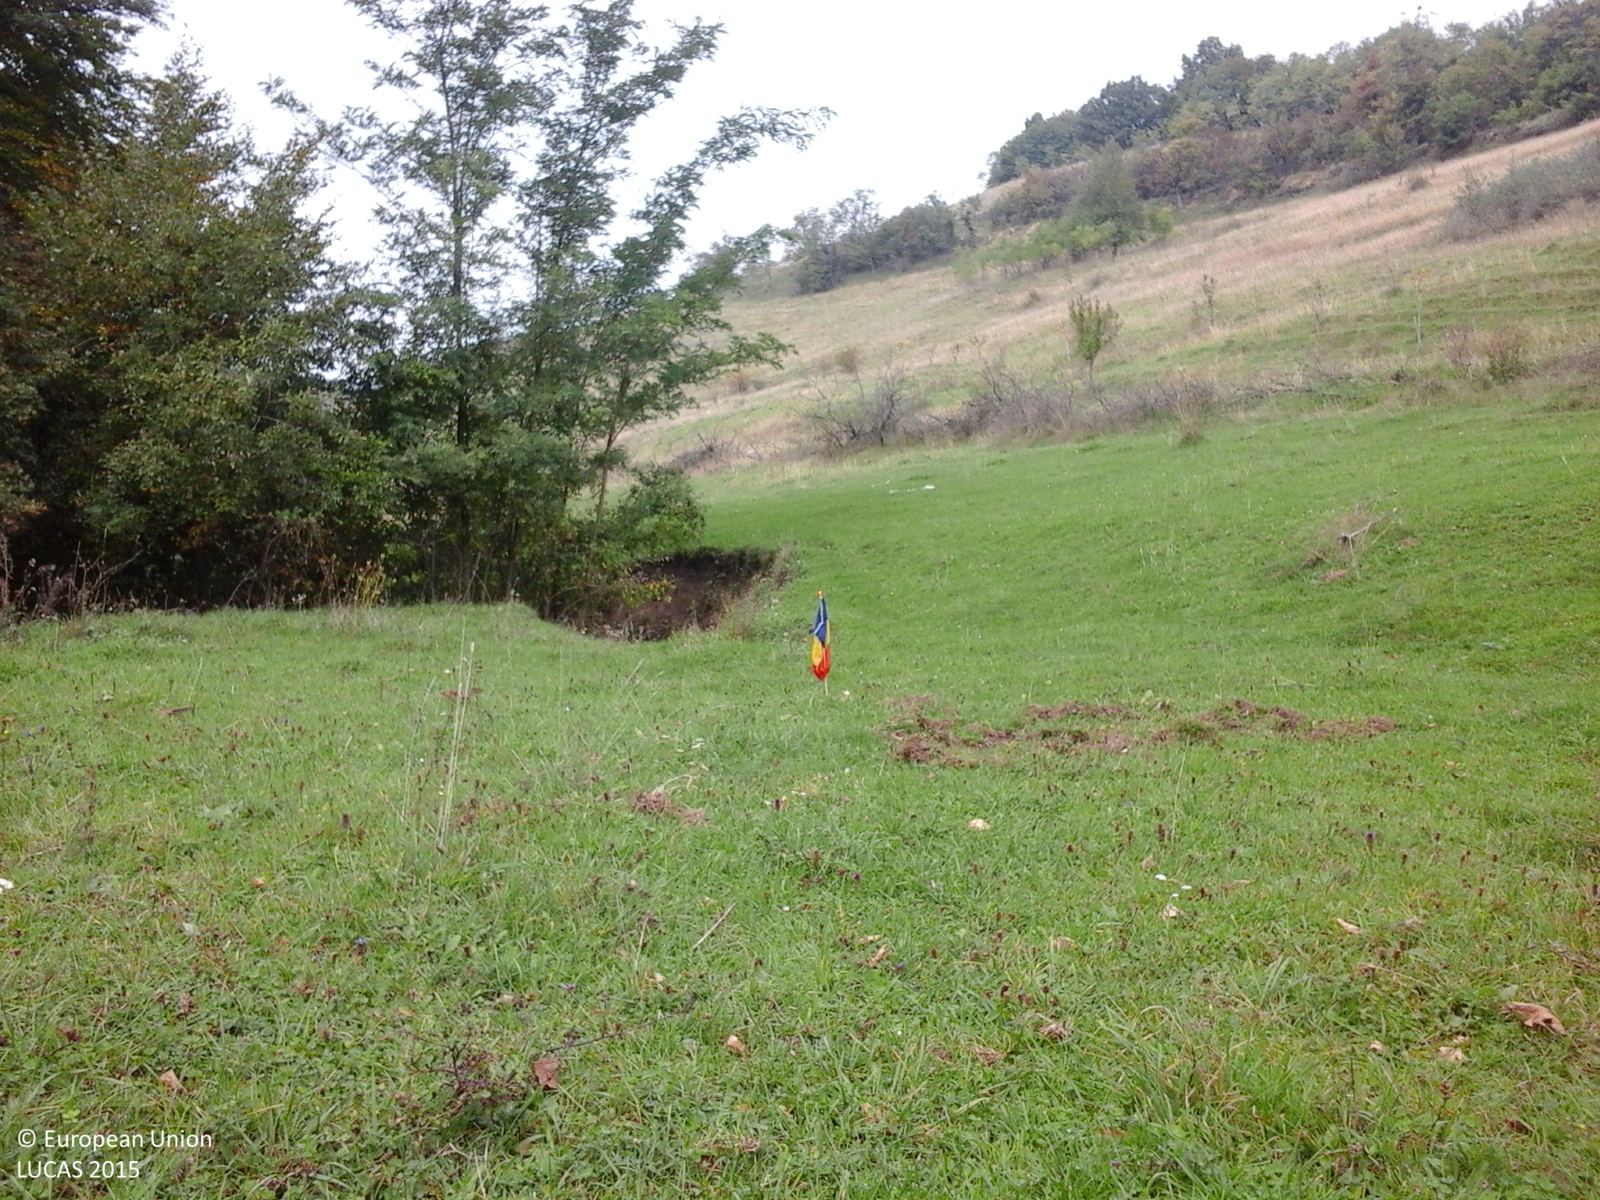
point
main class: Grassland
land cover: Grassland without tree/shrub cover
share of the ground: > 75 %
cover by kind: herbaceous plants 100 %
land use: Agriculture (excluding fallow land and kitchen gardens)
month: October
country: RO
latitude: 46.3129
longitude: 24.8578
